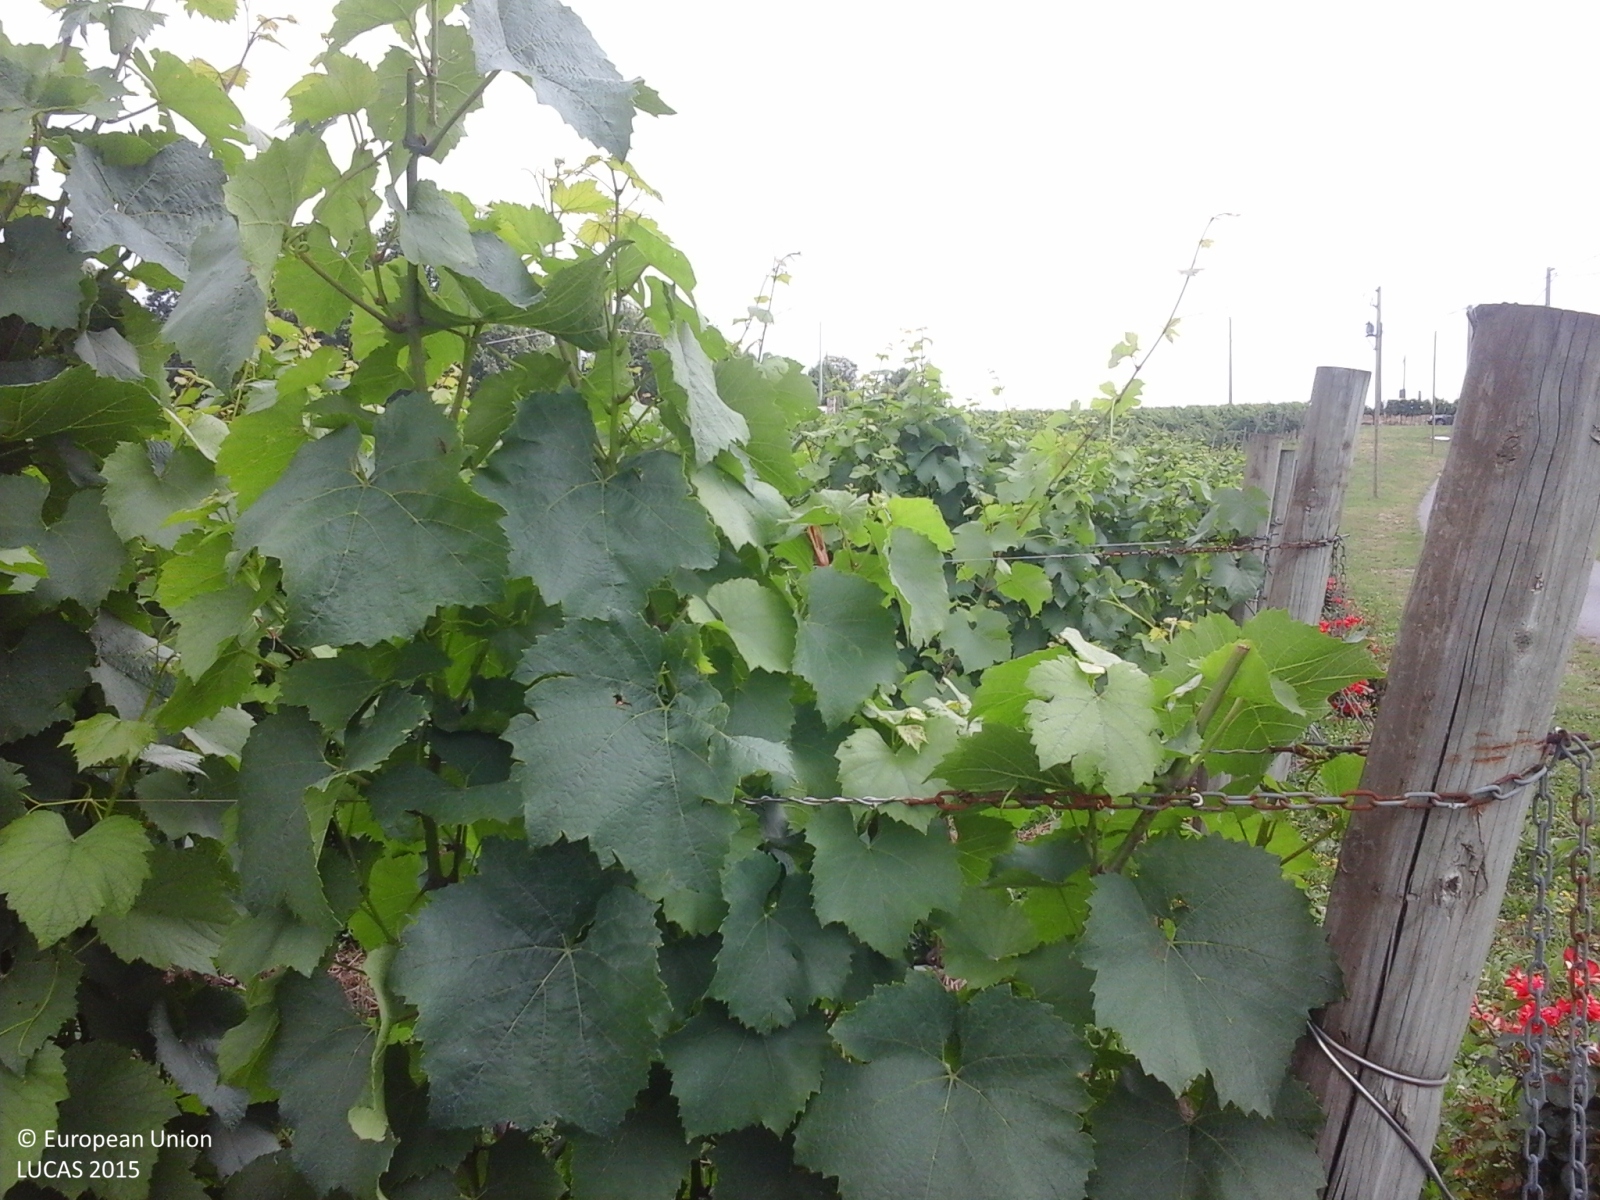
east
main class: Cropland
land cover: Vineyards
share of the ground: 25 - 50 %
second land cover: Grassland without tree/shrub cover
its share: > 75 %
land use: Agriculture (excluding fallow land and kitchen gardens)
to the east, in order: Vineyards; Grassland without tree/shrub cover; Artificial constructions in urban areas; Other cereals
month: June
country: IT
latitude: 45.6305
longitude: 9.9104
